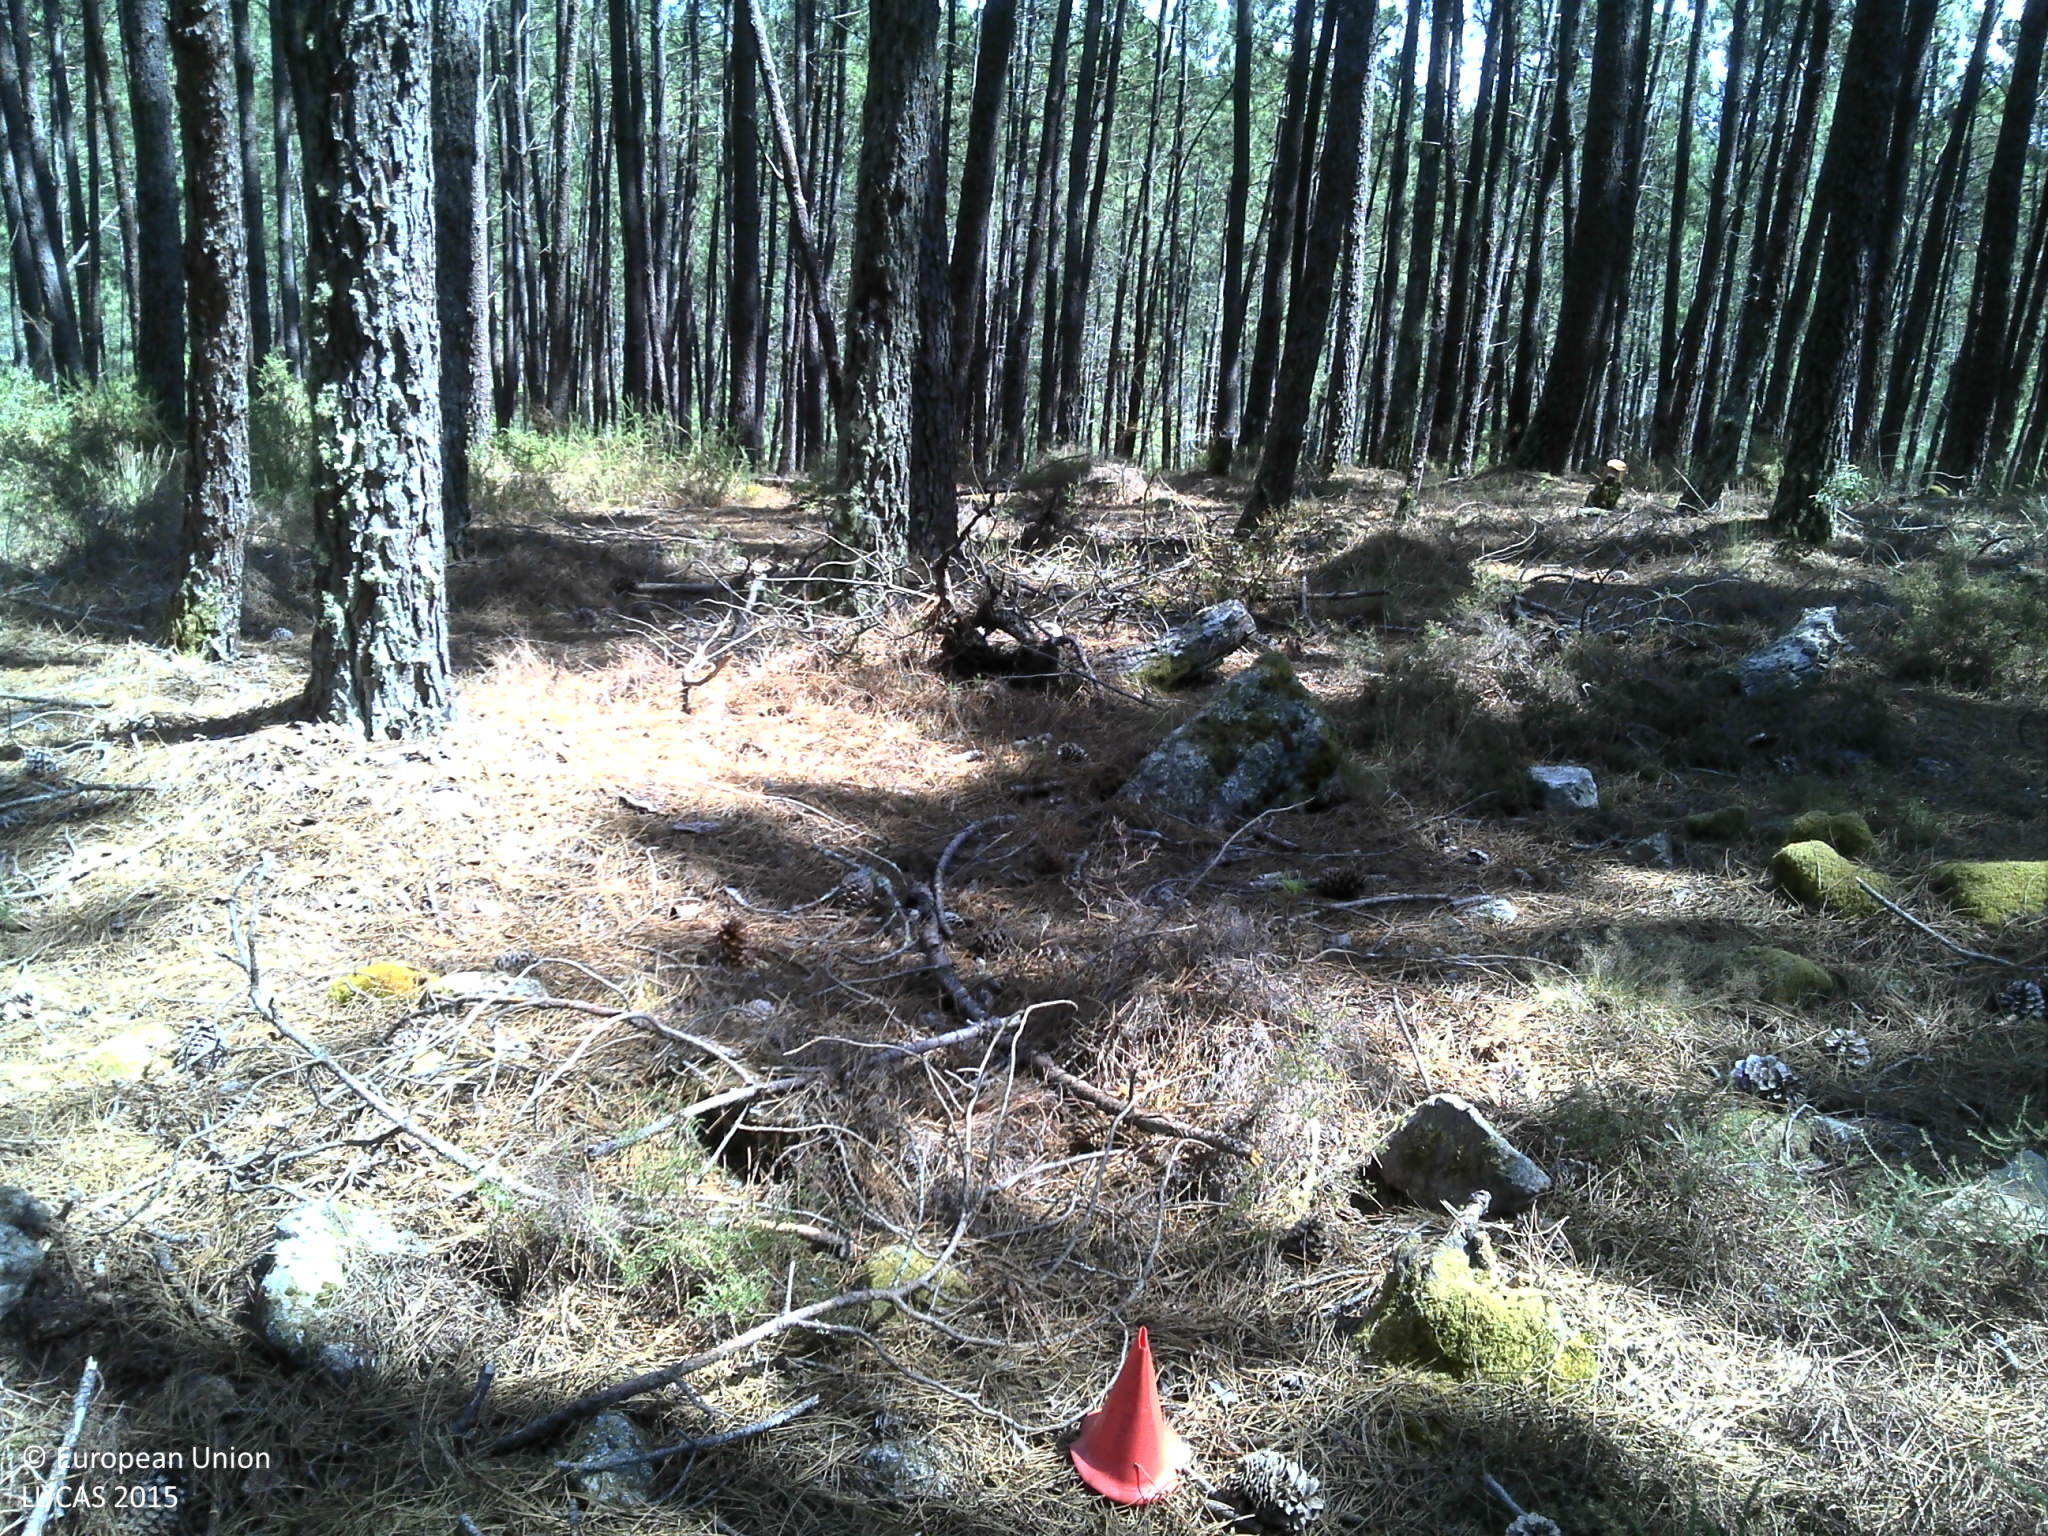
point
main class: Woodland
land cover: Pine dominated coniferous woodland
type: coniferous forest of the mediterranean region
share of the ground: > 75 %
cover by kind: coniferous forest trees 90 %, shrubs 5 %, unconsolidated bare surface 5 %
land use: Forestry
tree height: > 5 m
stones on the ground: 10 - 25 %
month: July
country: PT
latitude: 41.6363
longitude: -8.0926
